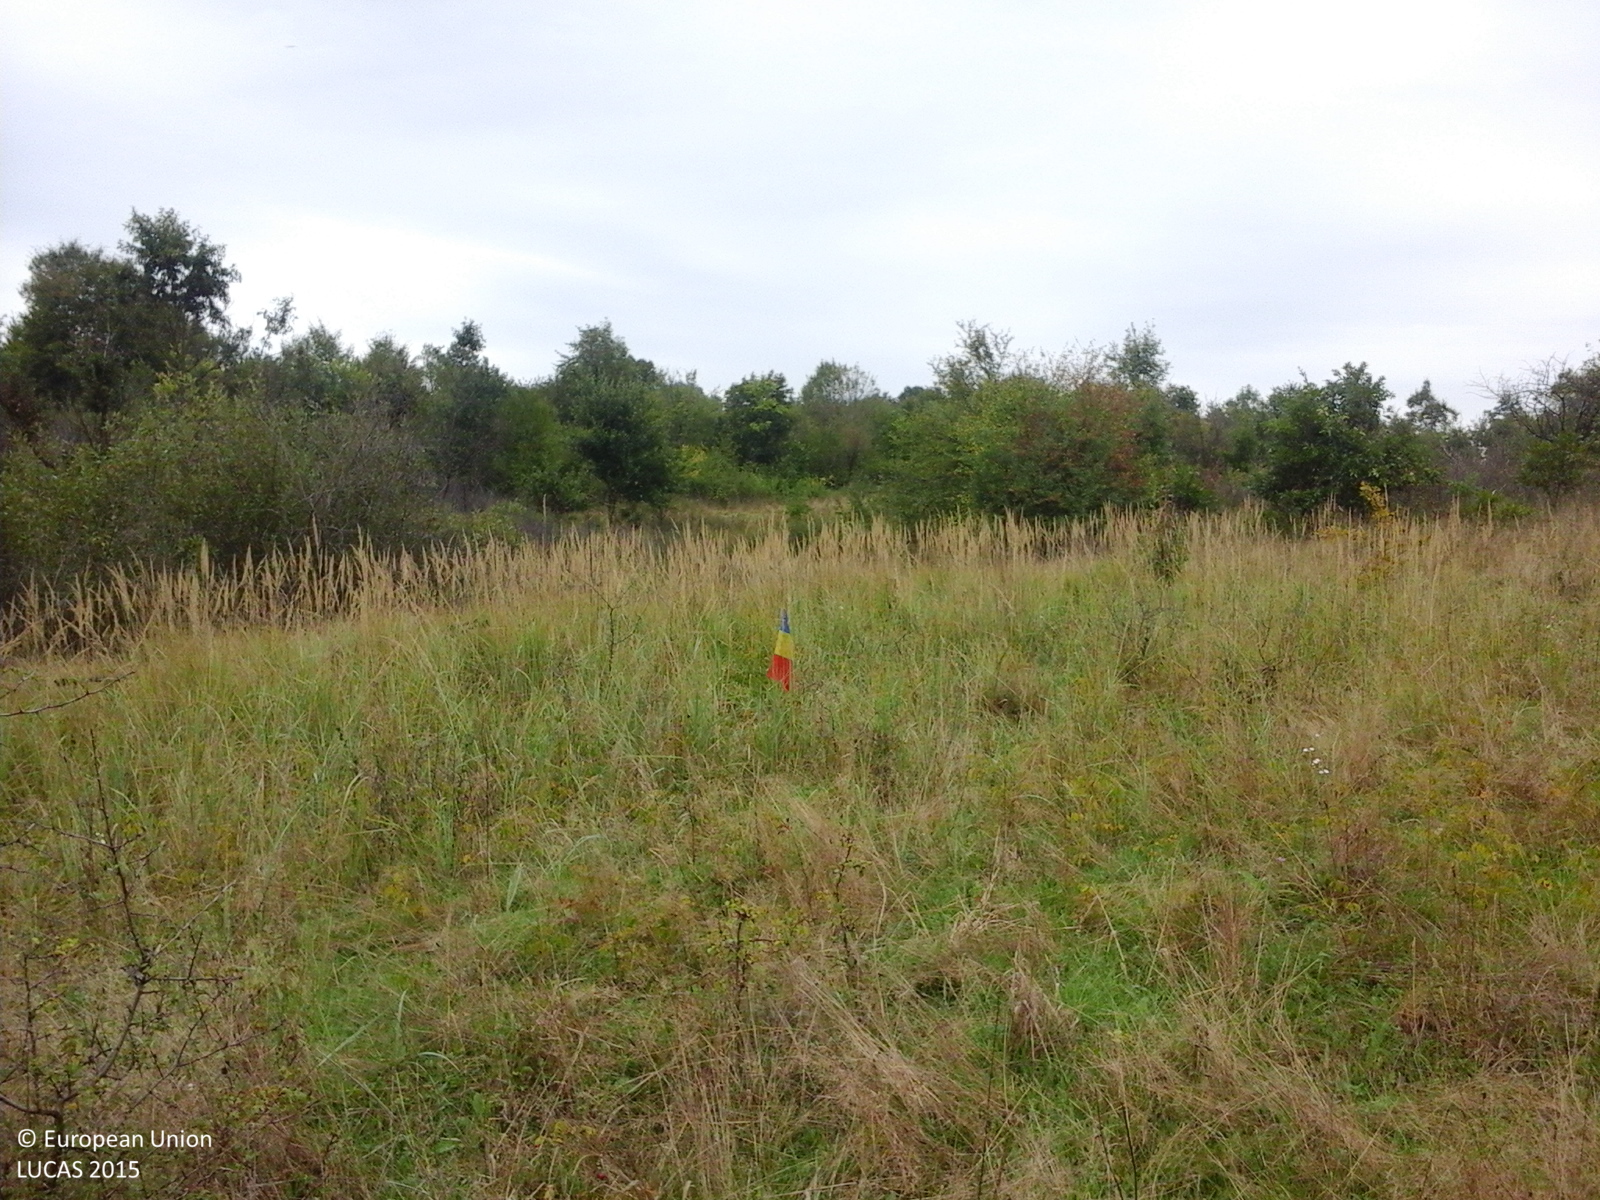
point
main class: Grassland
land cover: Spontaneously vegetated surfaces
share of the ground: > 75 %
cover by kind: herbaceous plants 100 %
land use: Fallow land
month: September
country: RO
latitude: 45.9552
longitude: 22.2369
